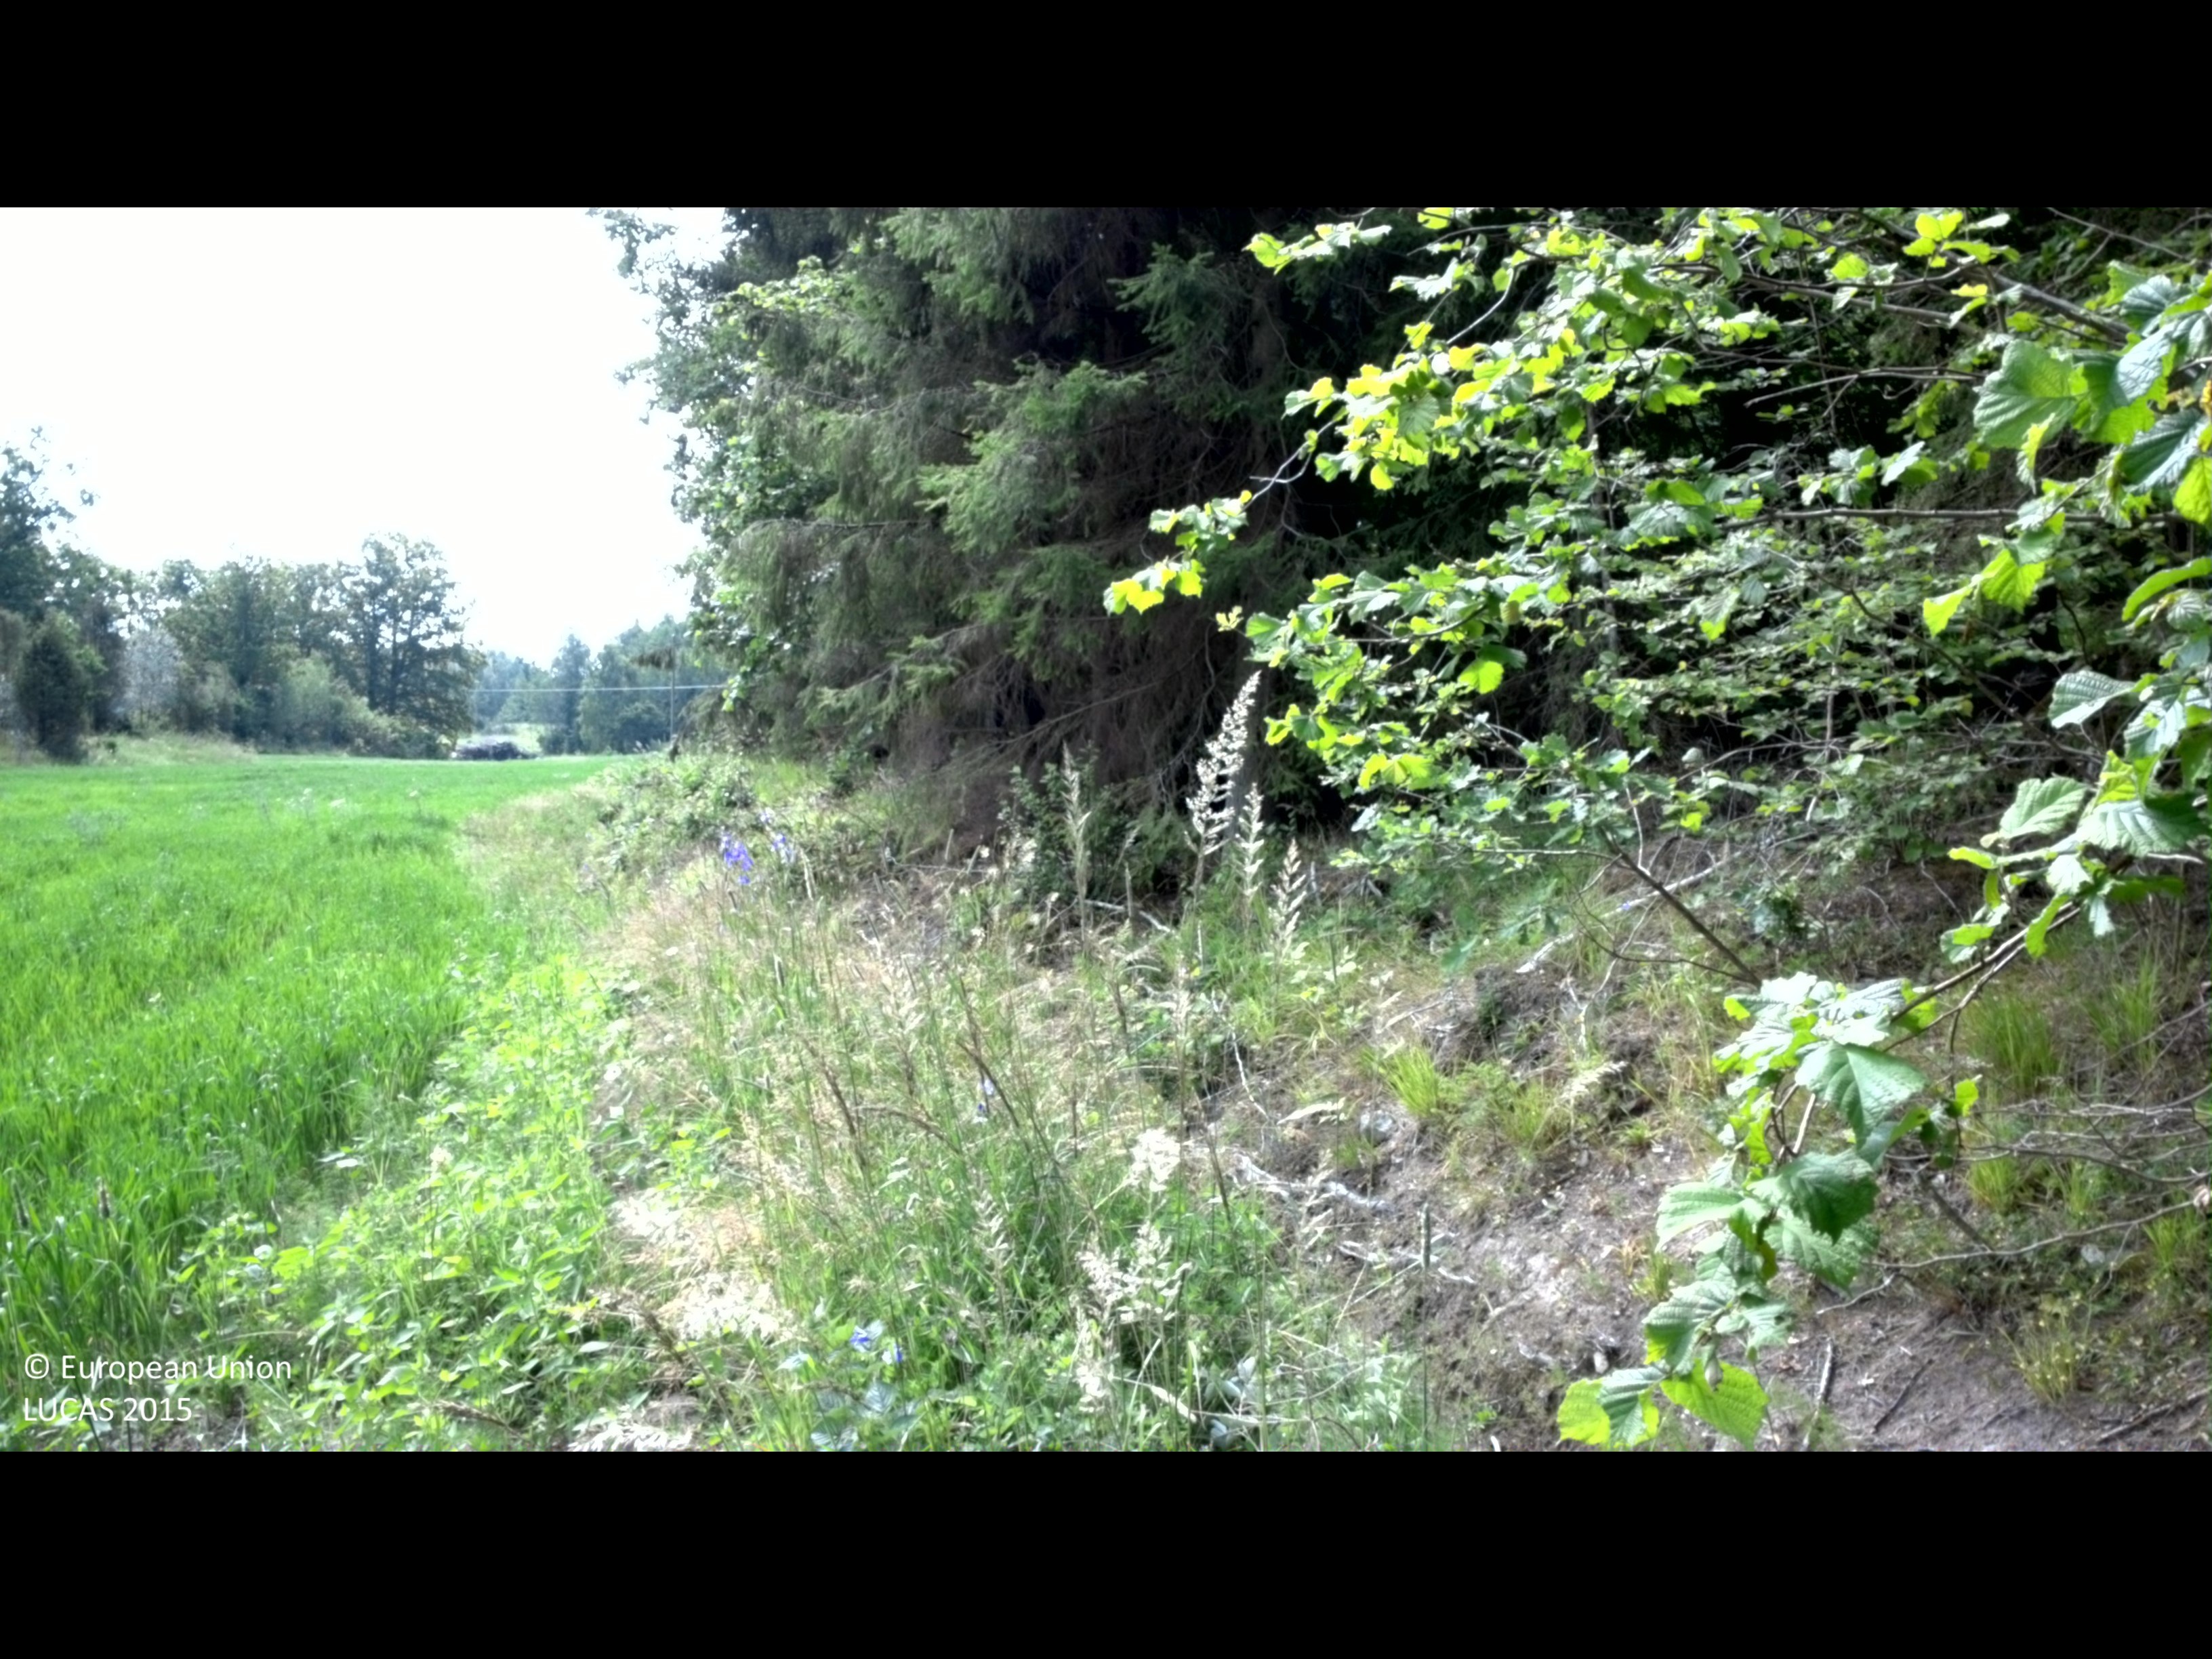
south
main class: Woodland
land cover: Other mixed woodland
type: boreal forest
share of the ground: > 75 %
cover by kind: coniferous forest trees 50 %, broadleaved forest trees 30 %, shrubs 15 %, herbaceous plants 5 %
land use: Forestry
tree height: > 5 m
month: July
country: SE
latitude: 58.2905
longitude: 16.6326
